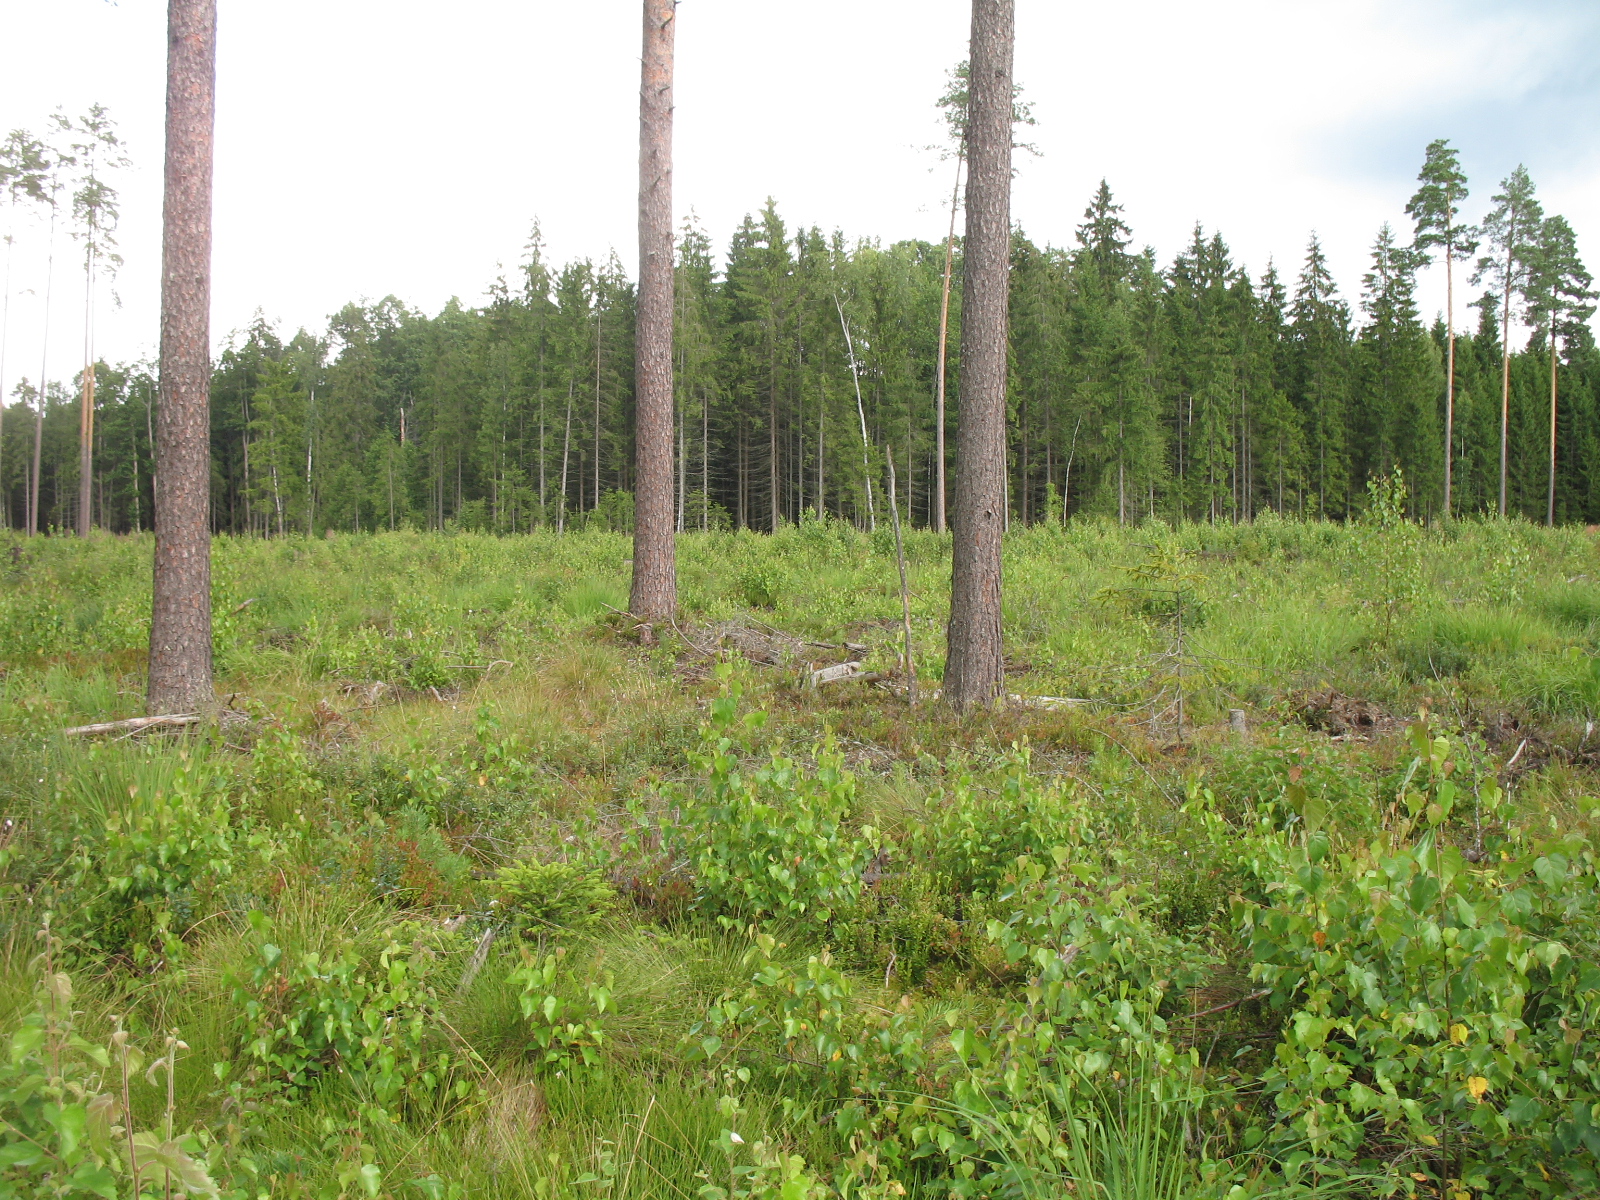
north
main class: Woodland
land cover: Broadleaved woodland
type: mire and swamp forests
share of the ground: 25 - 50 %
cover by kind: herbaceous plants 45 %, broadleaved forest trees 40 %, lichens and mosses 10 %, coniferous forest trees 5 %
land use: Forestry
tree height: < 5 m
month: July
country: LV
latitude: 56.3800
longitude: 25.1564
